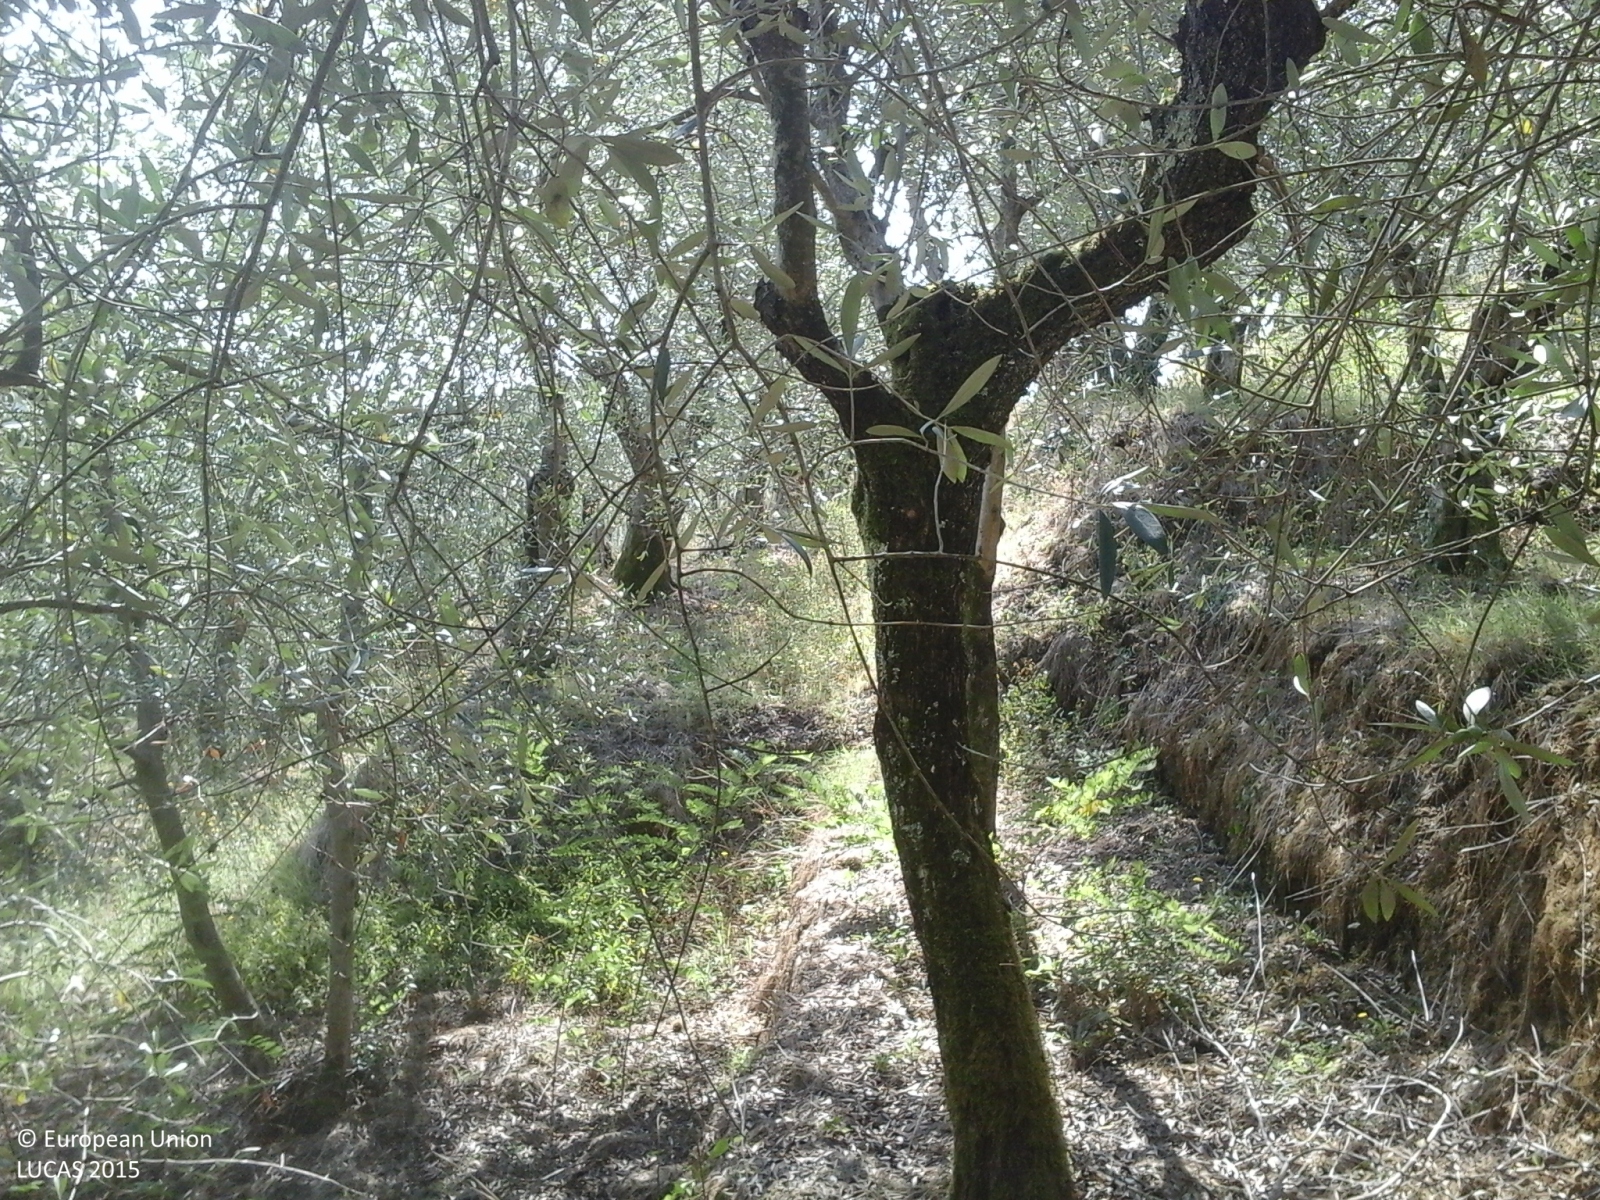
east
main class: Cropland
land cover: Olive groves
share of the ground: > 75 %
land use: Agriculture (excluding fallow land and kitchen gardens)
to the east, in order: Olive groves; Temporary grasslands; Tracks; Olive groves; Grassland with sparse tree/shrub cover; Tracks; Grassland with sparse tree/shrub cover; Tracks; Grassland with sparse tree/shrub cover; Tracks; Pine dominated coniferous woodland
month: August
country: IT
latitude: 43.7354
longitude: 10.6067
